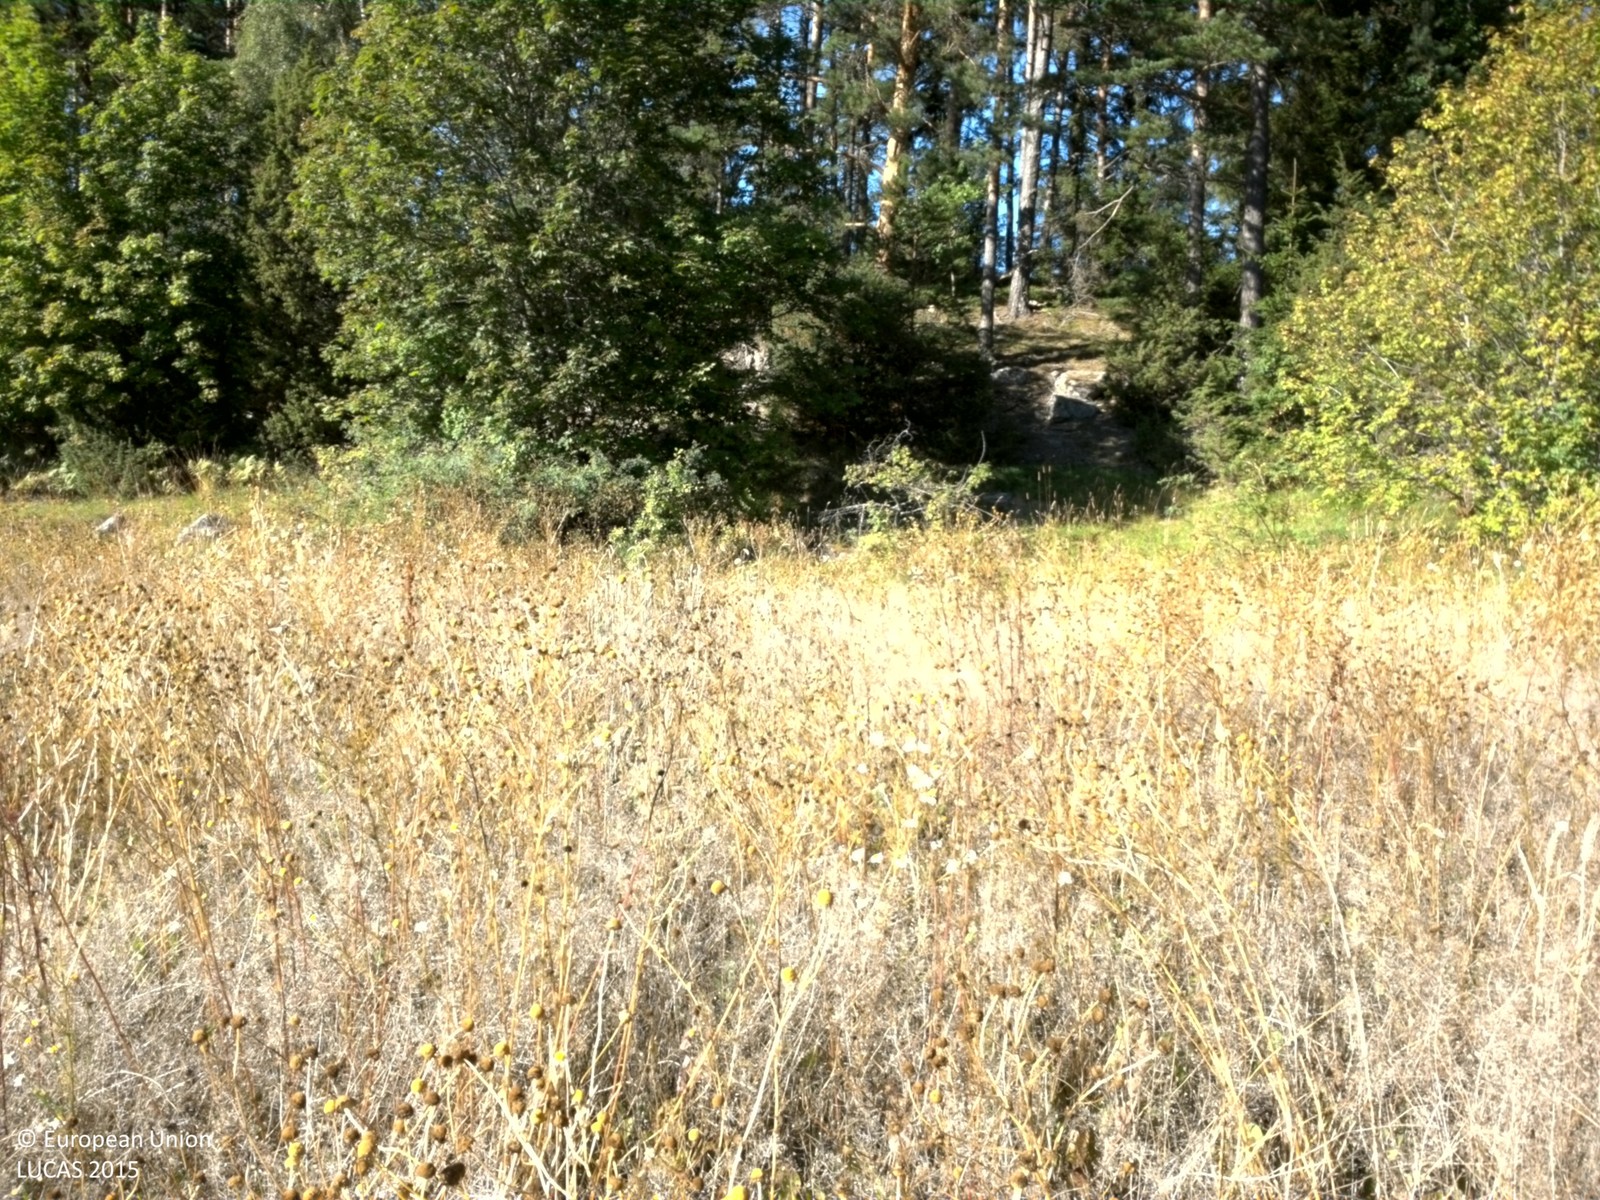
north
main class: Grassland
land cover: Spontaneously vegetated surfaces
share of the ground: > 75 %
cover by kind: herbaceous plants 100 %
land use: Fallow land
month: August
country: SE
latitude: 59.9416
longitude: 17.8883
